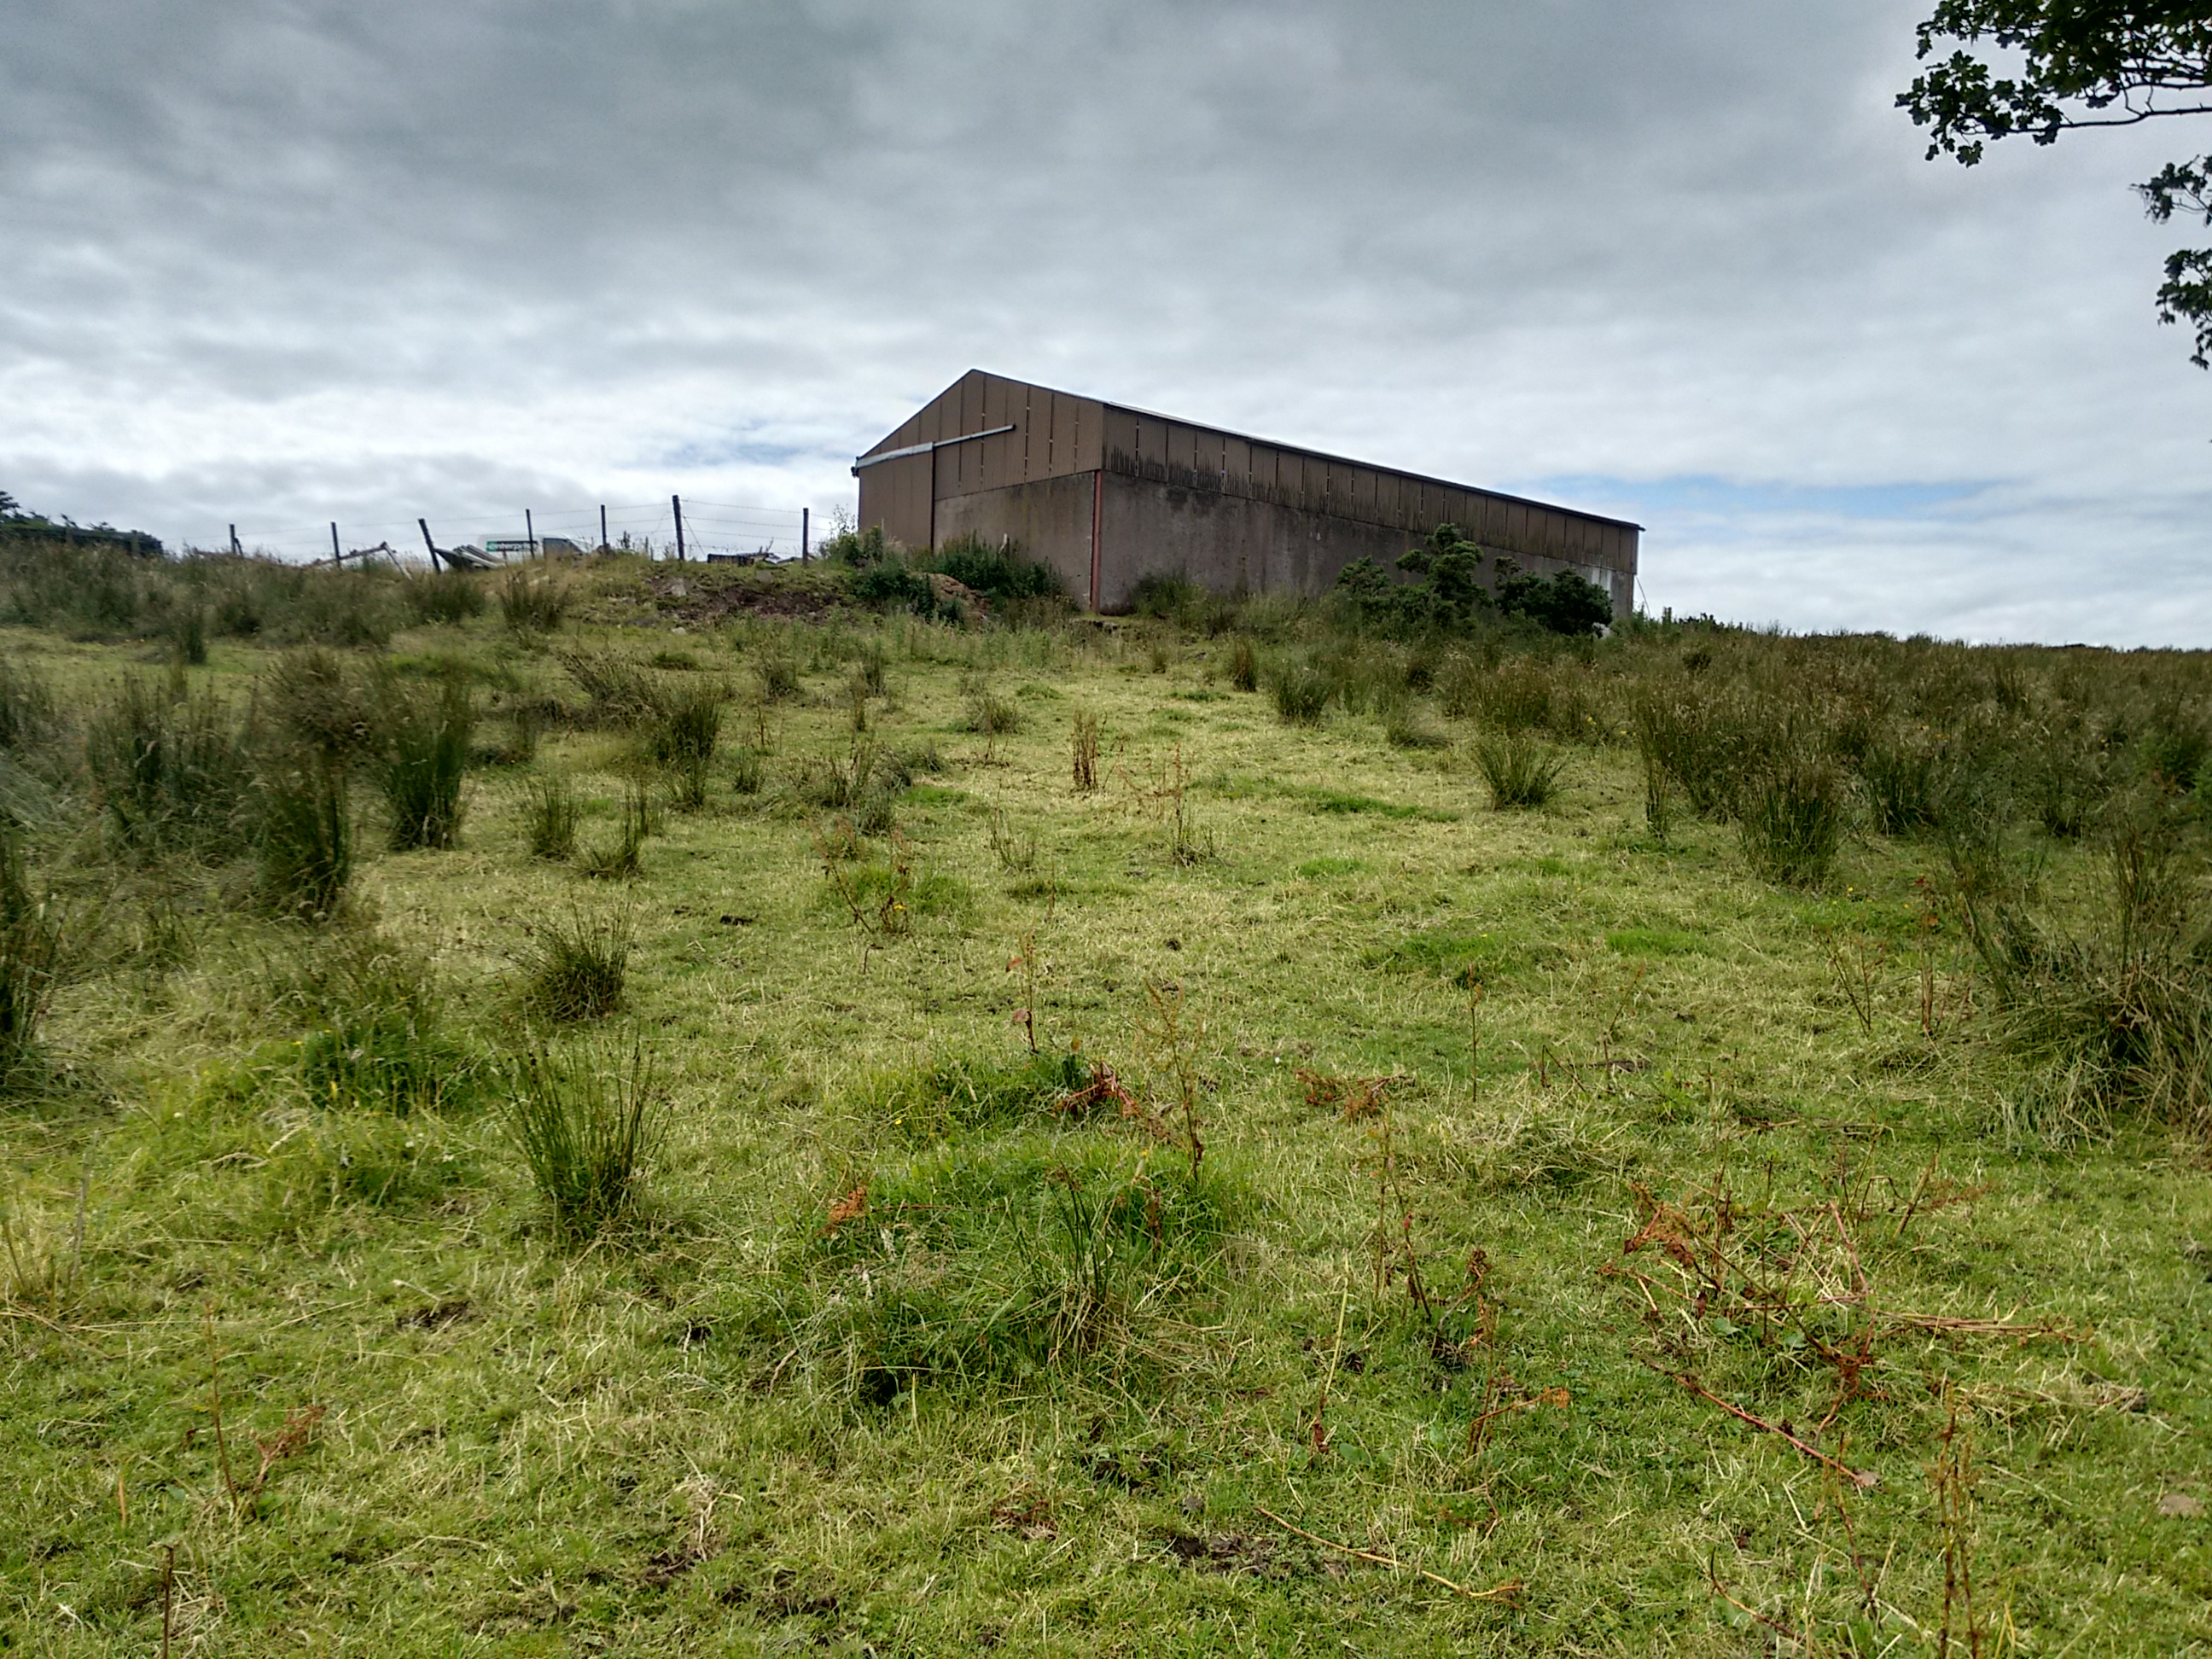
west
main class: Grassland
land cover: Grassland with sparse tree/shrub cover
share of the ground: > 75 %
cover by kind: herbaceous plants 95 %, broadleaved forest trees 5 %
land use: Agriculture (excluding fallow land and kitchen gardens)
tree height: > 5 m
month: August
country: GB
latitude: 54.5335
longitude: -6.9360
